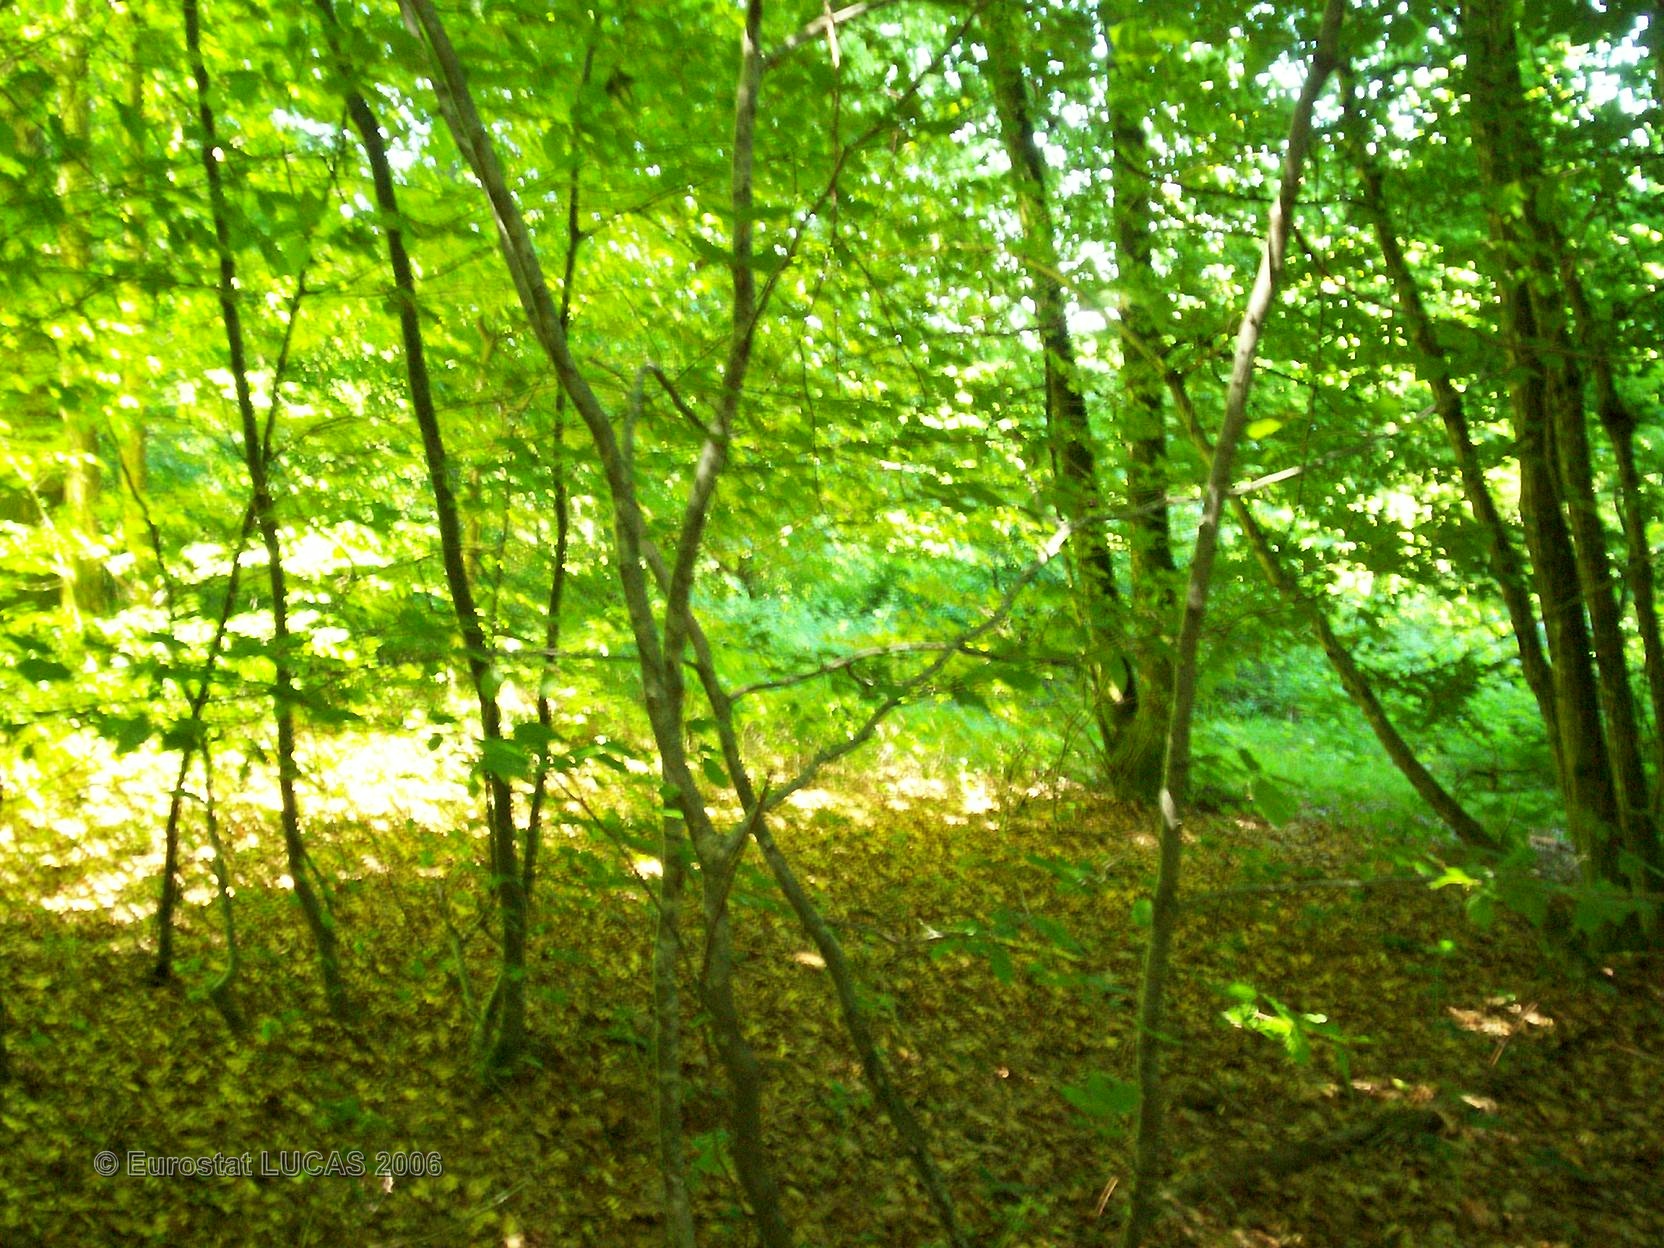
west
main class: Woodland
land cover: Broadleaved forest
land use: Forestry
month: June
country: FR
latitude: 47.4126
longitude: 6.0122
